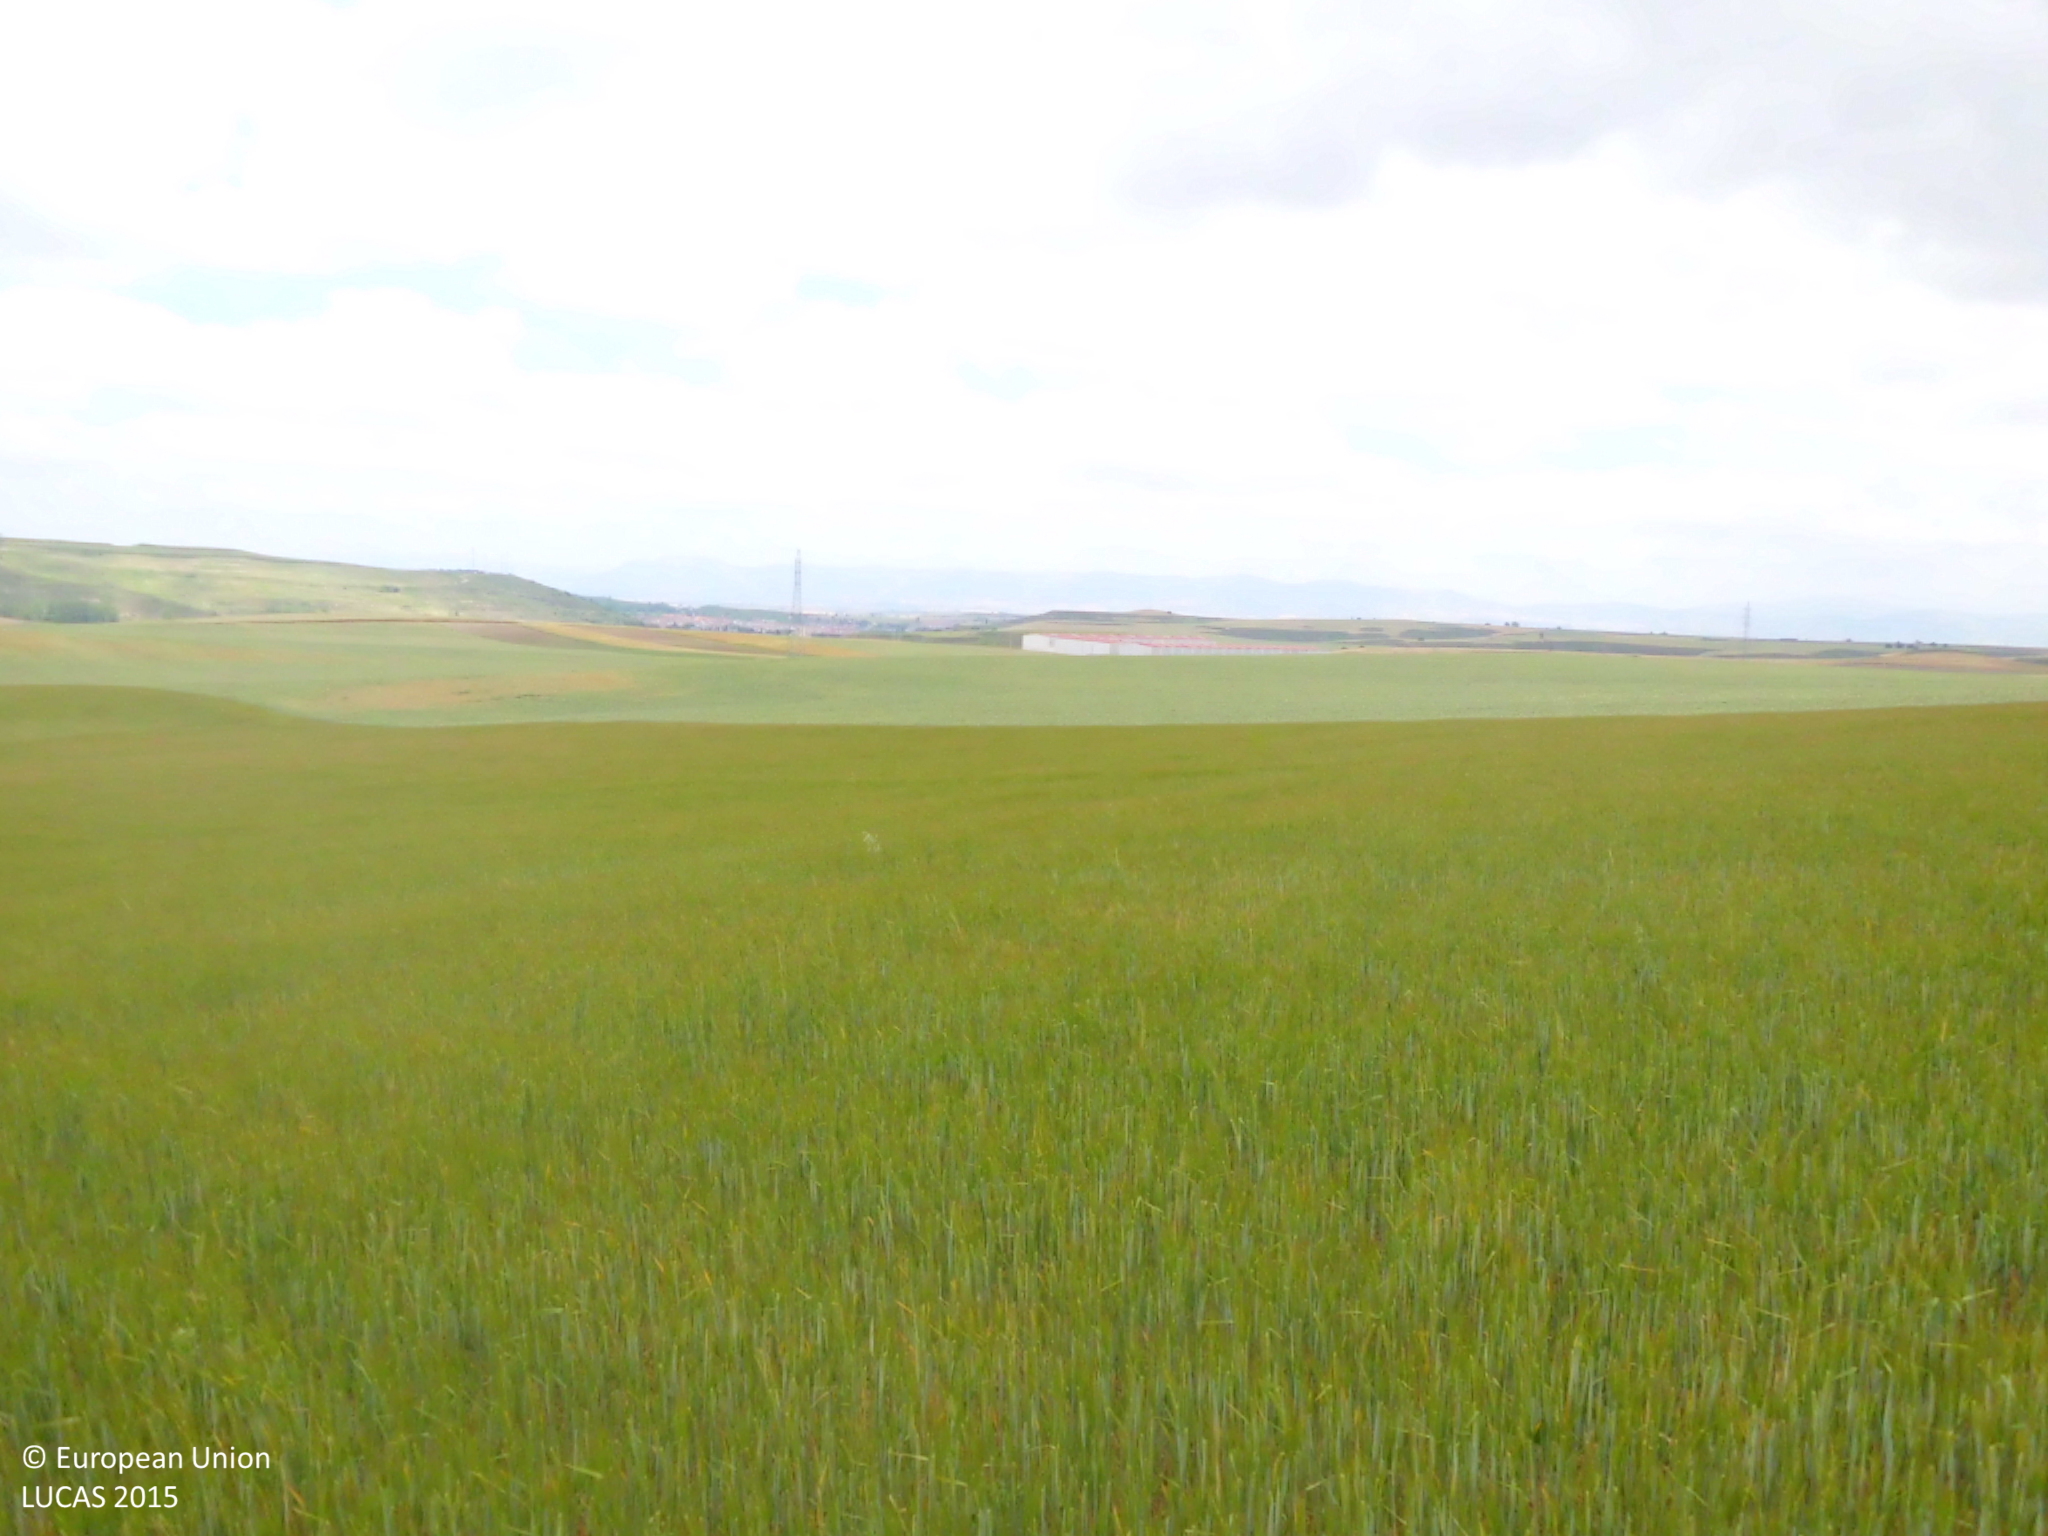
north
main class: Cropland
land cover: Barley
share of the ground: > 75 %
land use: Agriculture (excluding fallow land and kitchen gardens)
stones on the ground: < 10 %
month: June
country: ES
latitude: 42.5203
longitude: -3.3125
